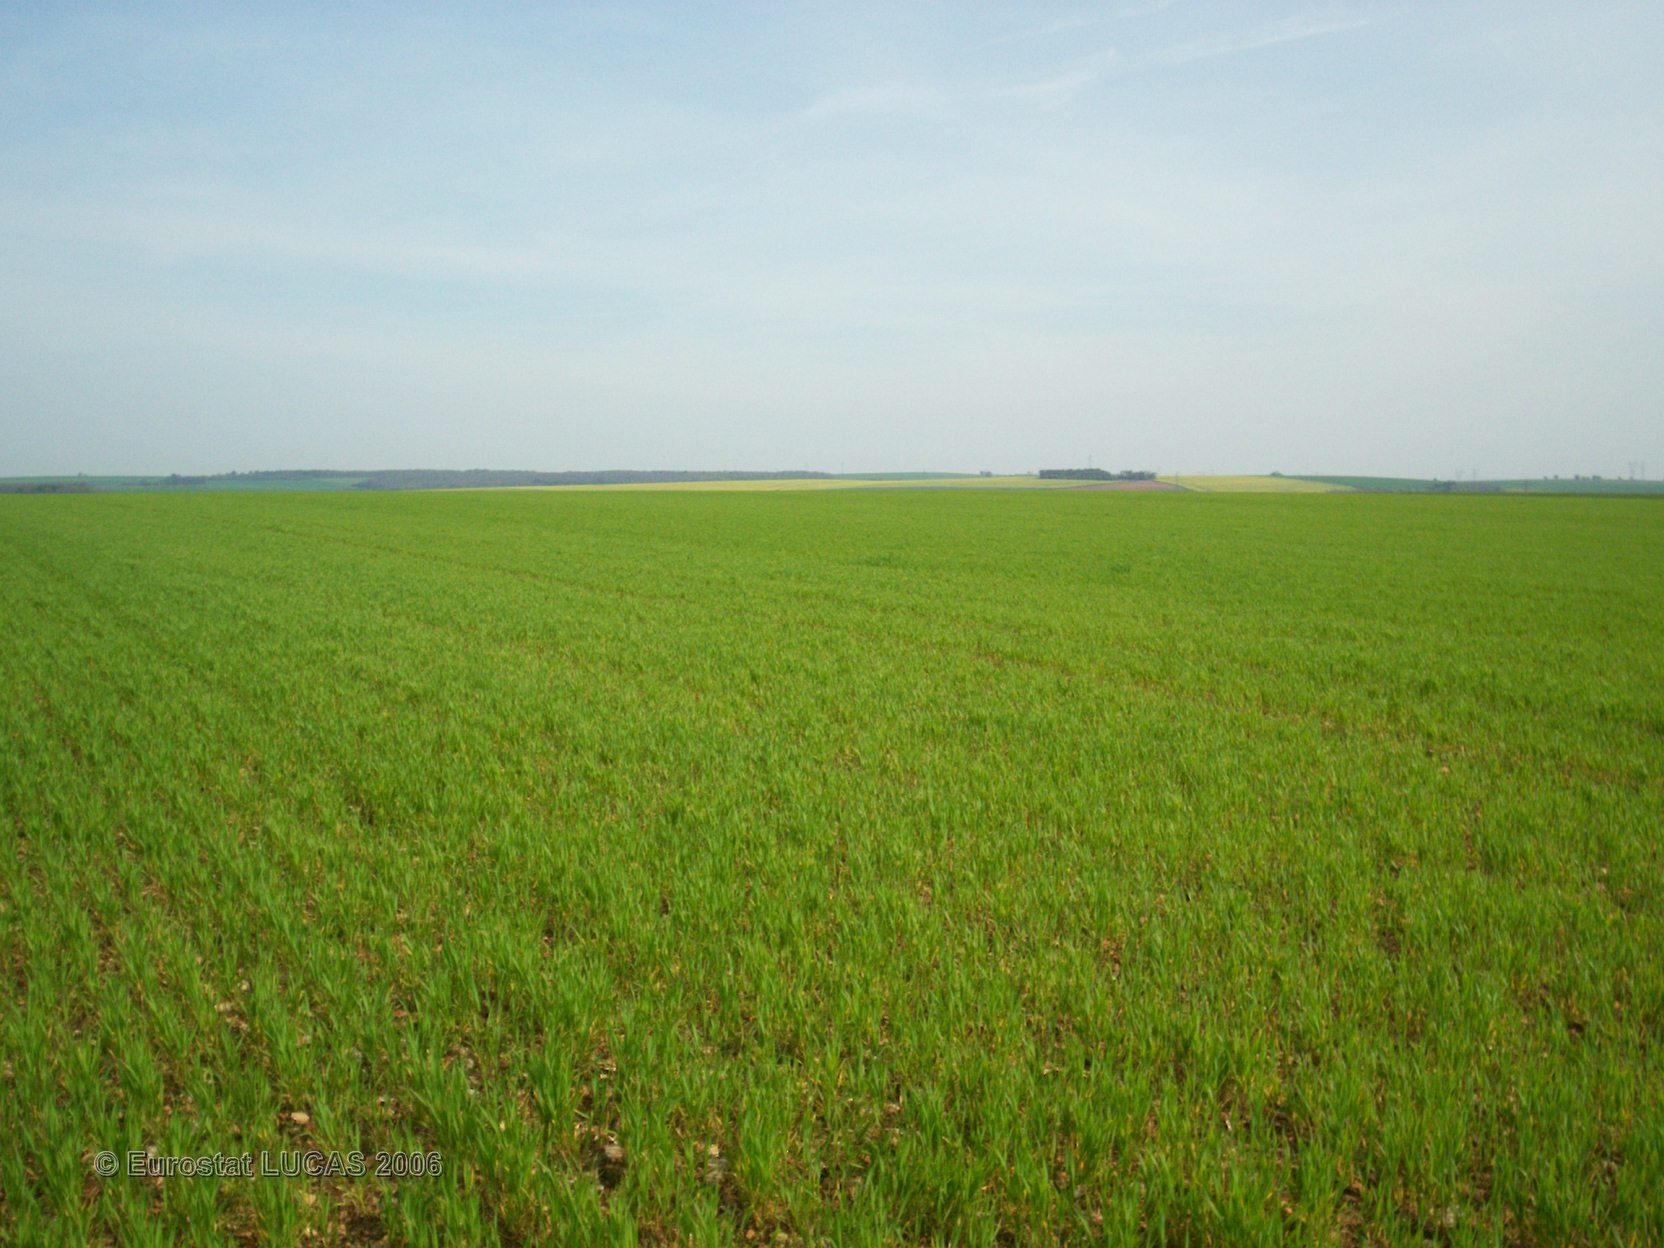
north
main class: Cropland
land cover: Common wheat
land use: Agriculture (excluding fallow land and kitchen gardens)
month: May
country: FR
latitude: 47.5650
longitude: 4.5362
